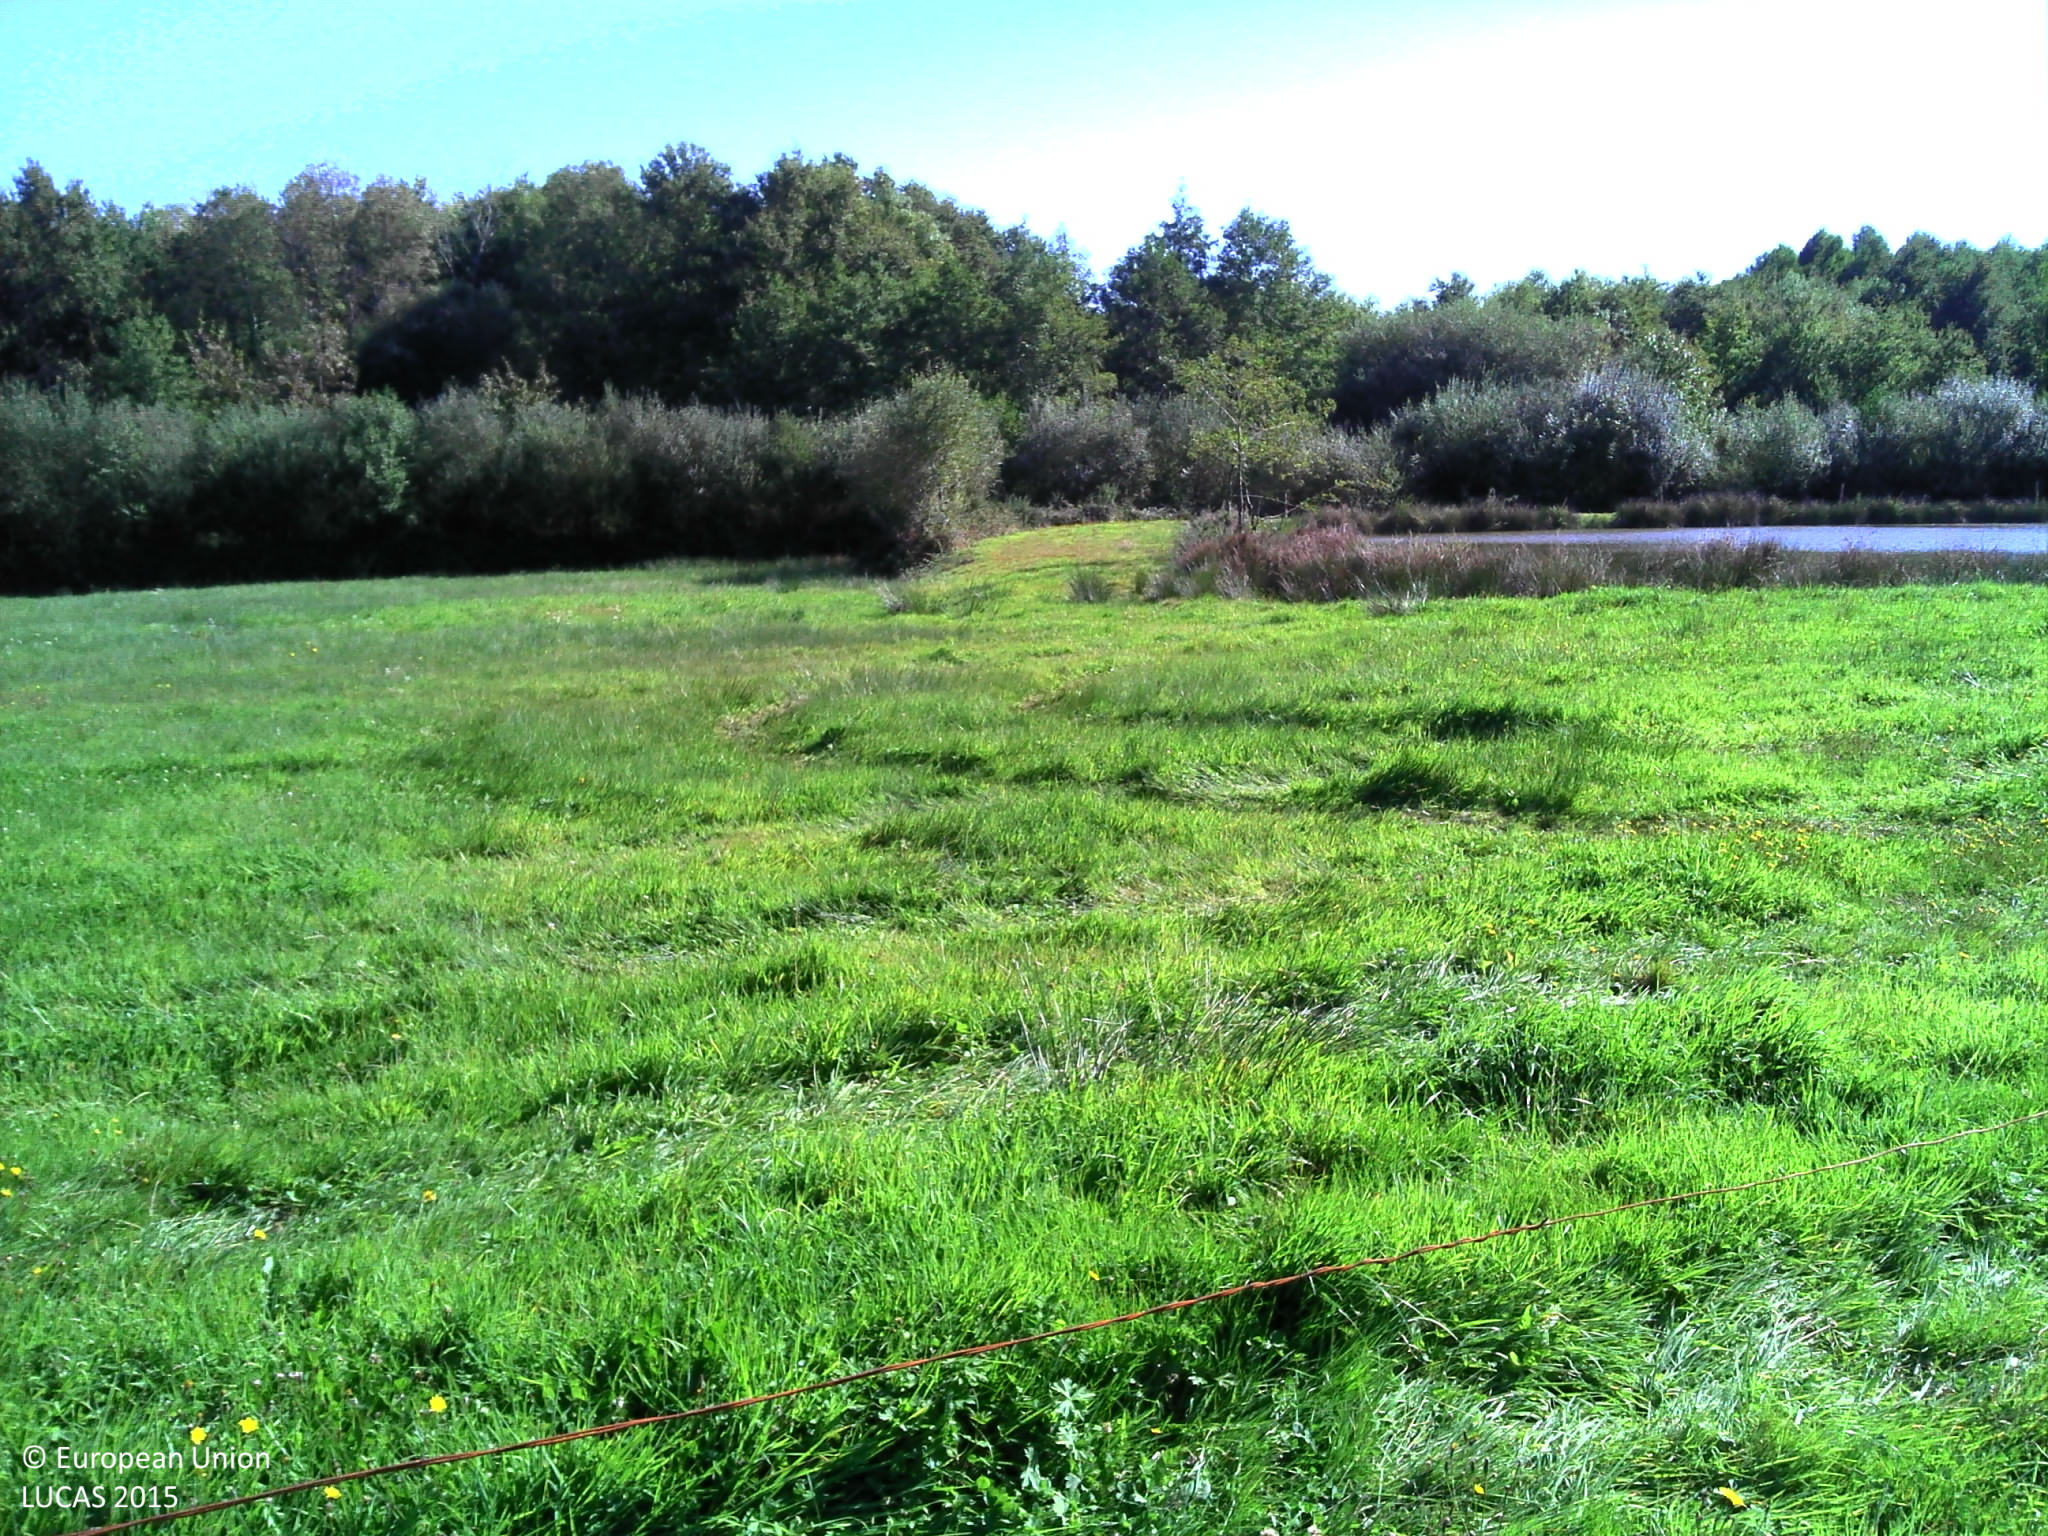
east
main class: Grassland
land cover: Grassland without tree/shrub cover
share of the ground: > 75 %
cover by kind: herbaceous plants 100 %
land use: Agriculture (excluding fallow land and kitchen gardens)
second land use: Amenities, museums, leisure
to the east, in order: Fences; Grassland without tree/shrub cover; Fences; Ditches and canals; Abandoned hedges; Tracks; Broadleaved woodland; Tracks; Broadleaved woodland; Spontaneously vegetated surfaces; Fences; Maize
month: September
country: FR
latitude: 46.5689
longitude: -1.2950
